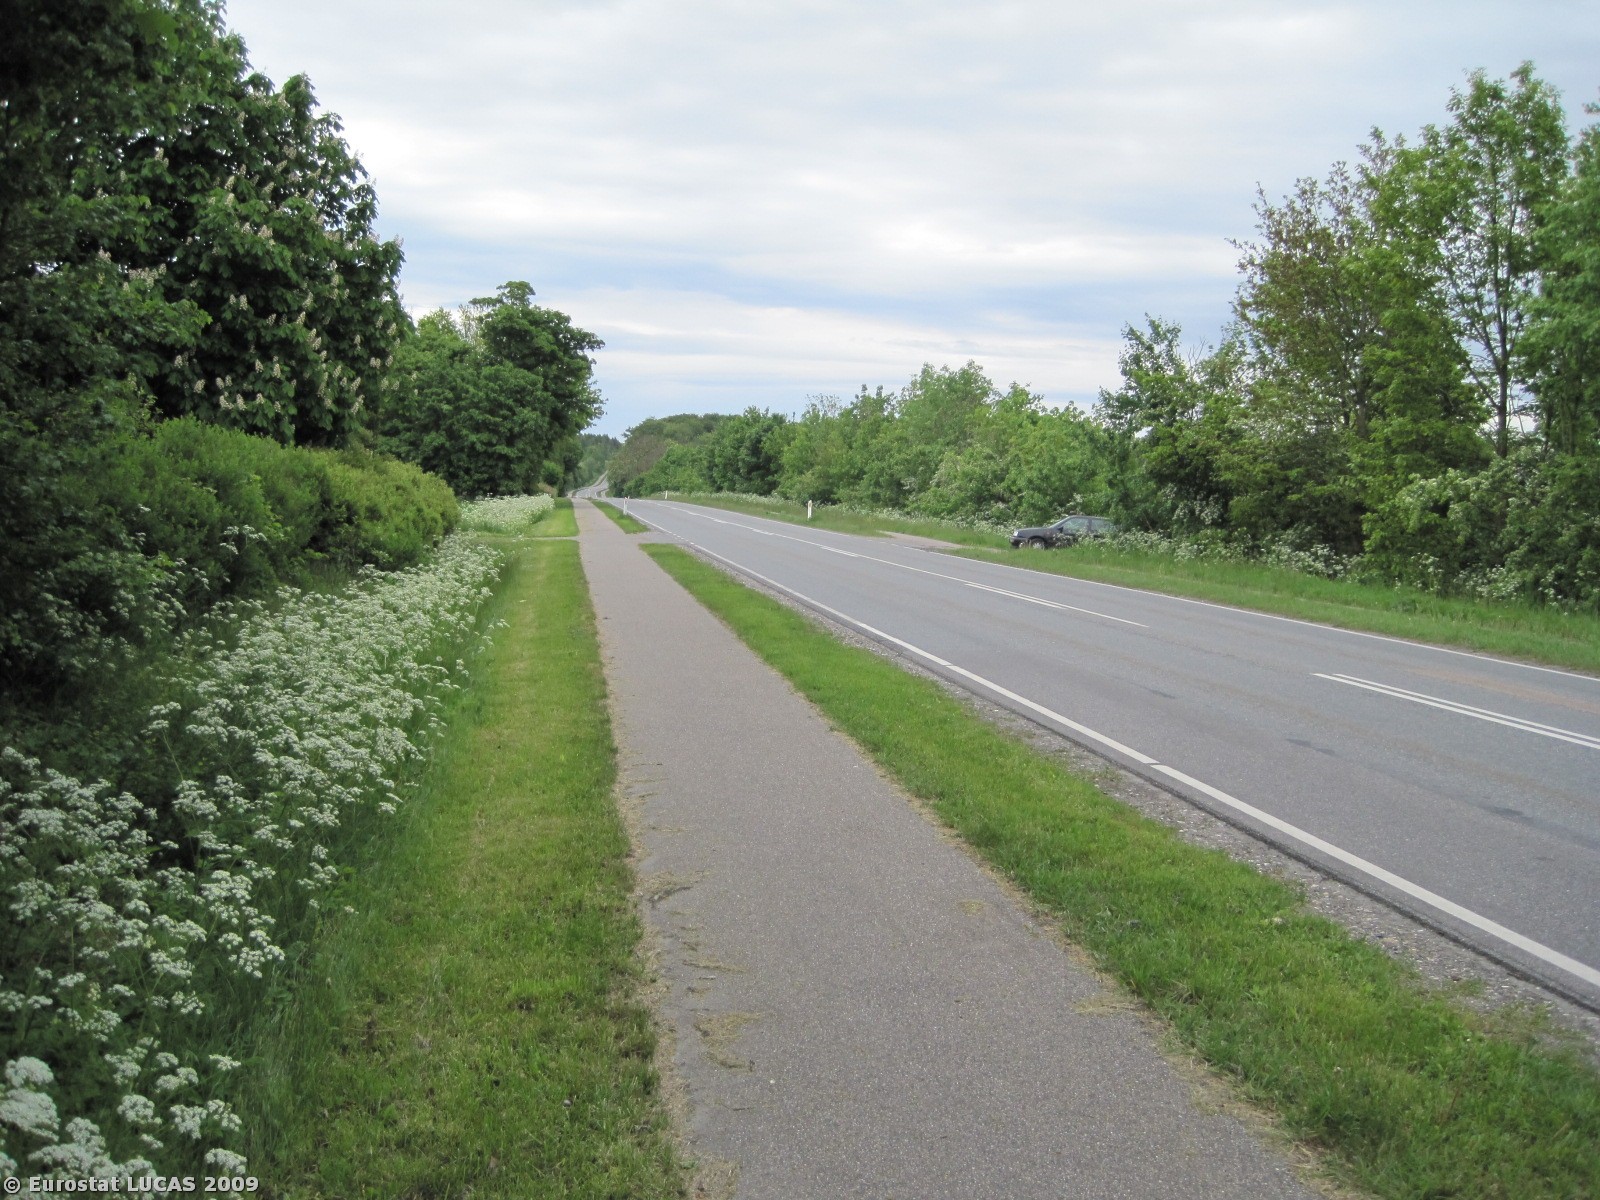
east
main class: Woodland
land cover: Broadleaved woodland
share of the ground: > 75 %
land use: Residential
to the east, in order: Broadleaved woodland; Artificial constructions in urban areas; Single bushes/trees; Barley; Broadleaved woodland; Artificial constructions in urban areas; Grass margins; Tracks; Grass margins; Paved roads, cycling and walking lanes; Grass margins; Tracks; Grass margins; Broadleaved woodland; Barley
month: May
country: DK
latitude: 56.7090
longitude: 10.0816
